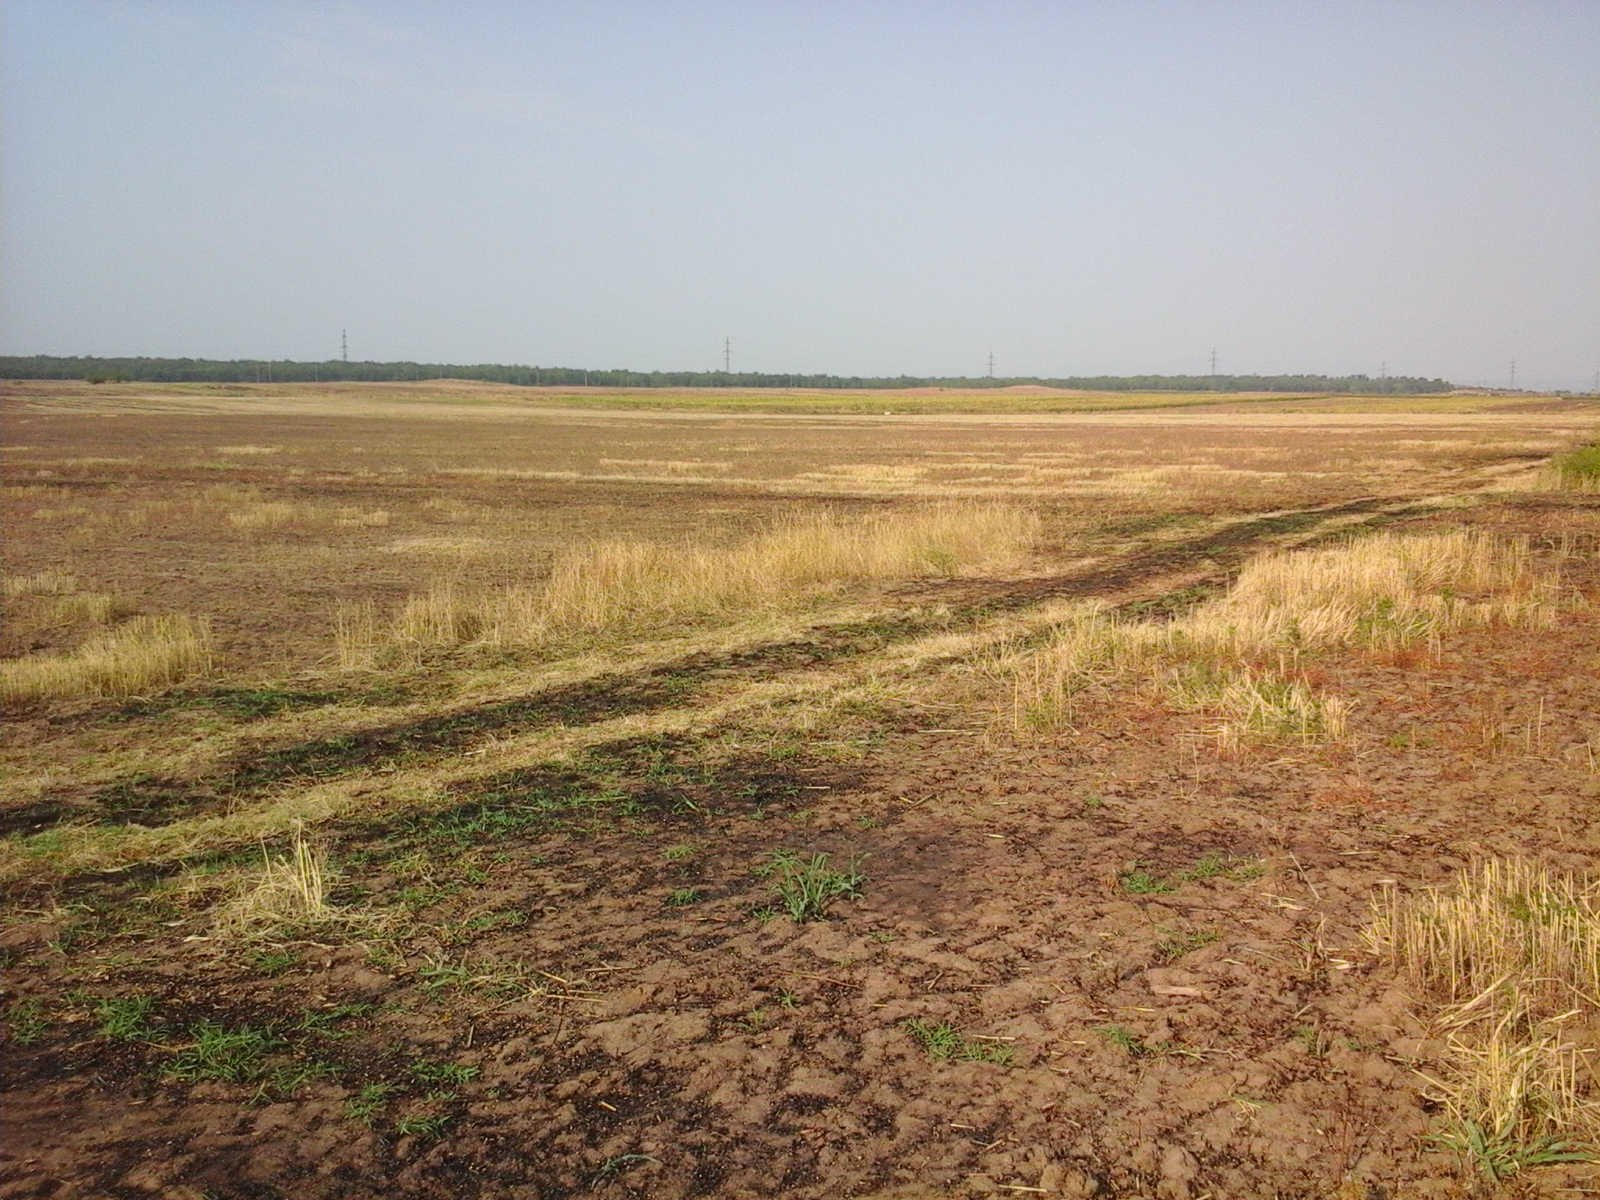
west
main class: Cropland
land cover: Barley
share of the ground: < 10 %
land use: Agriculture (excluding fallow land and kitchen gardens)
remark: Burnt area
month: August
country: RO
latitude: 44.2950
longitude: 22.7107
